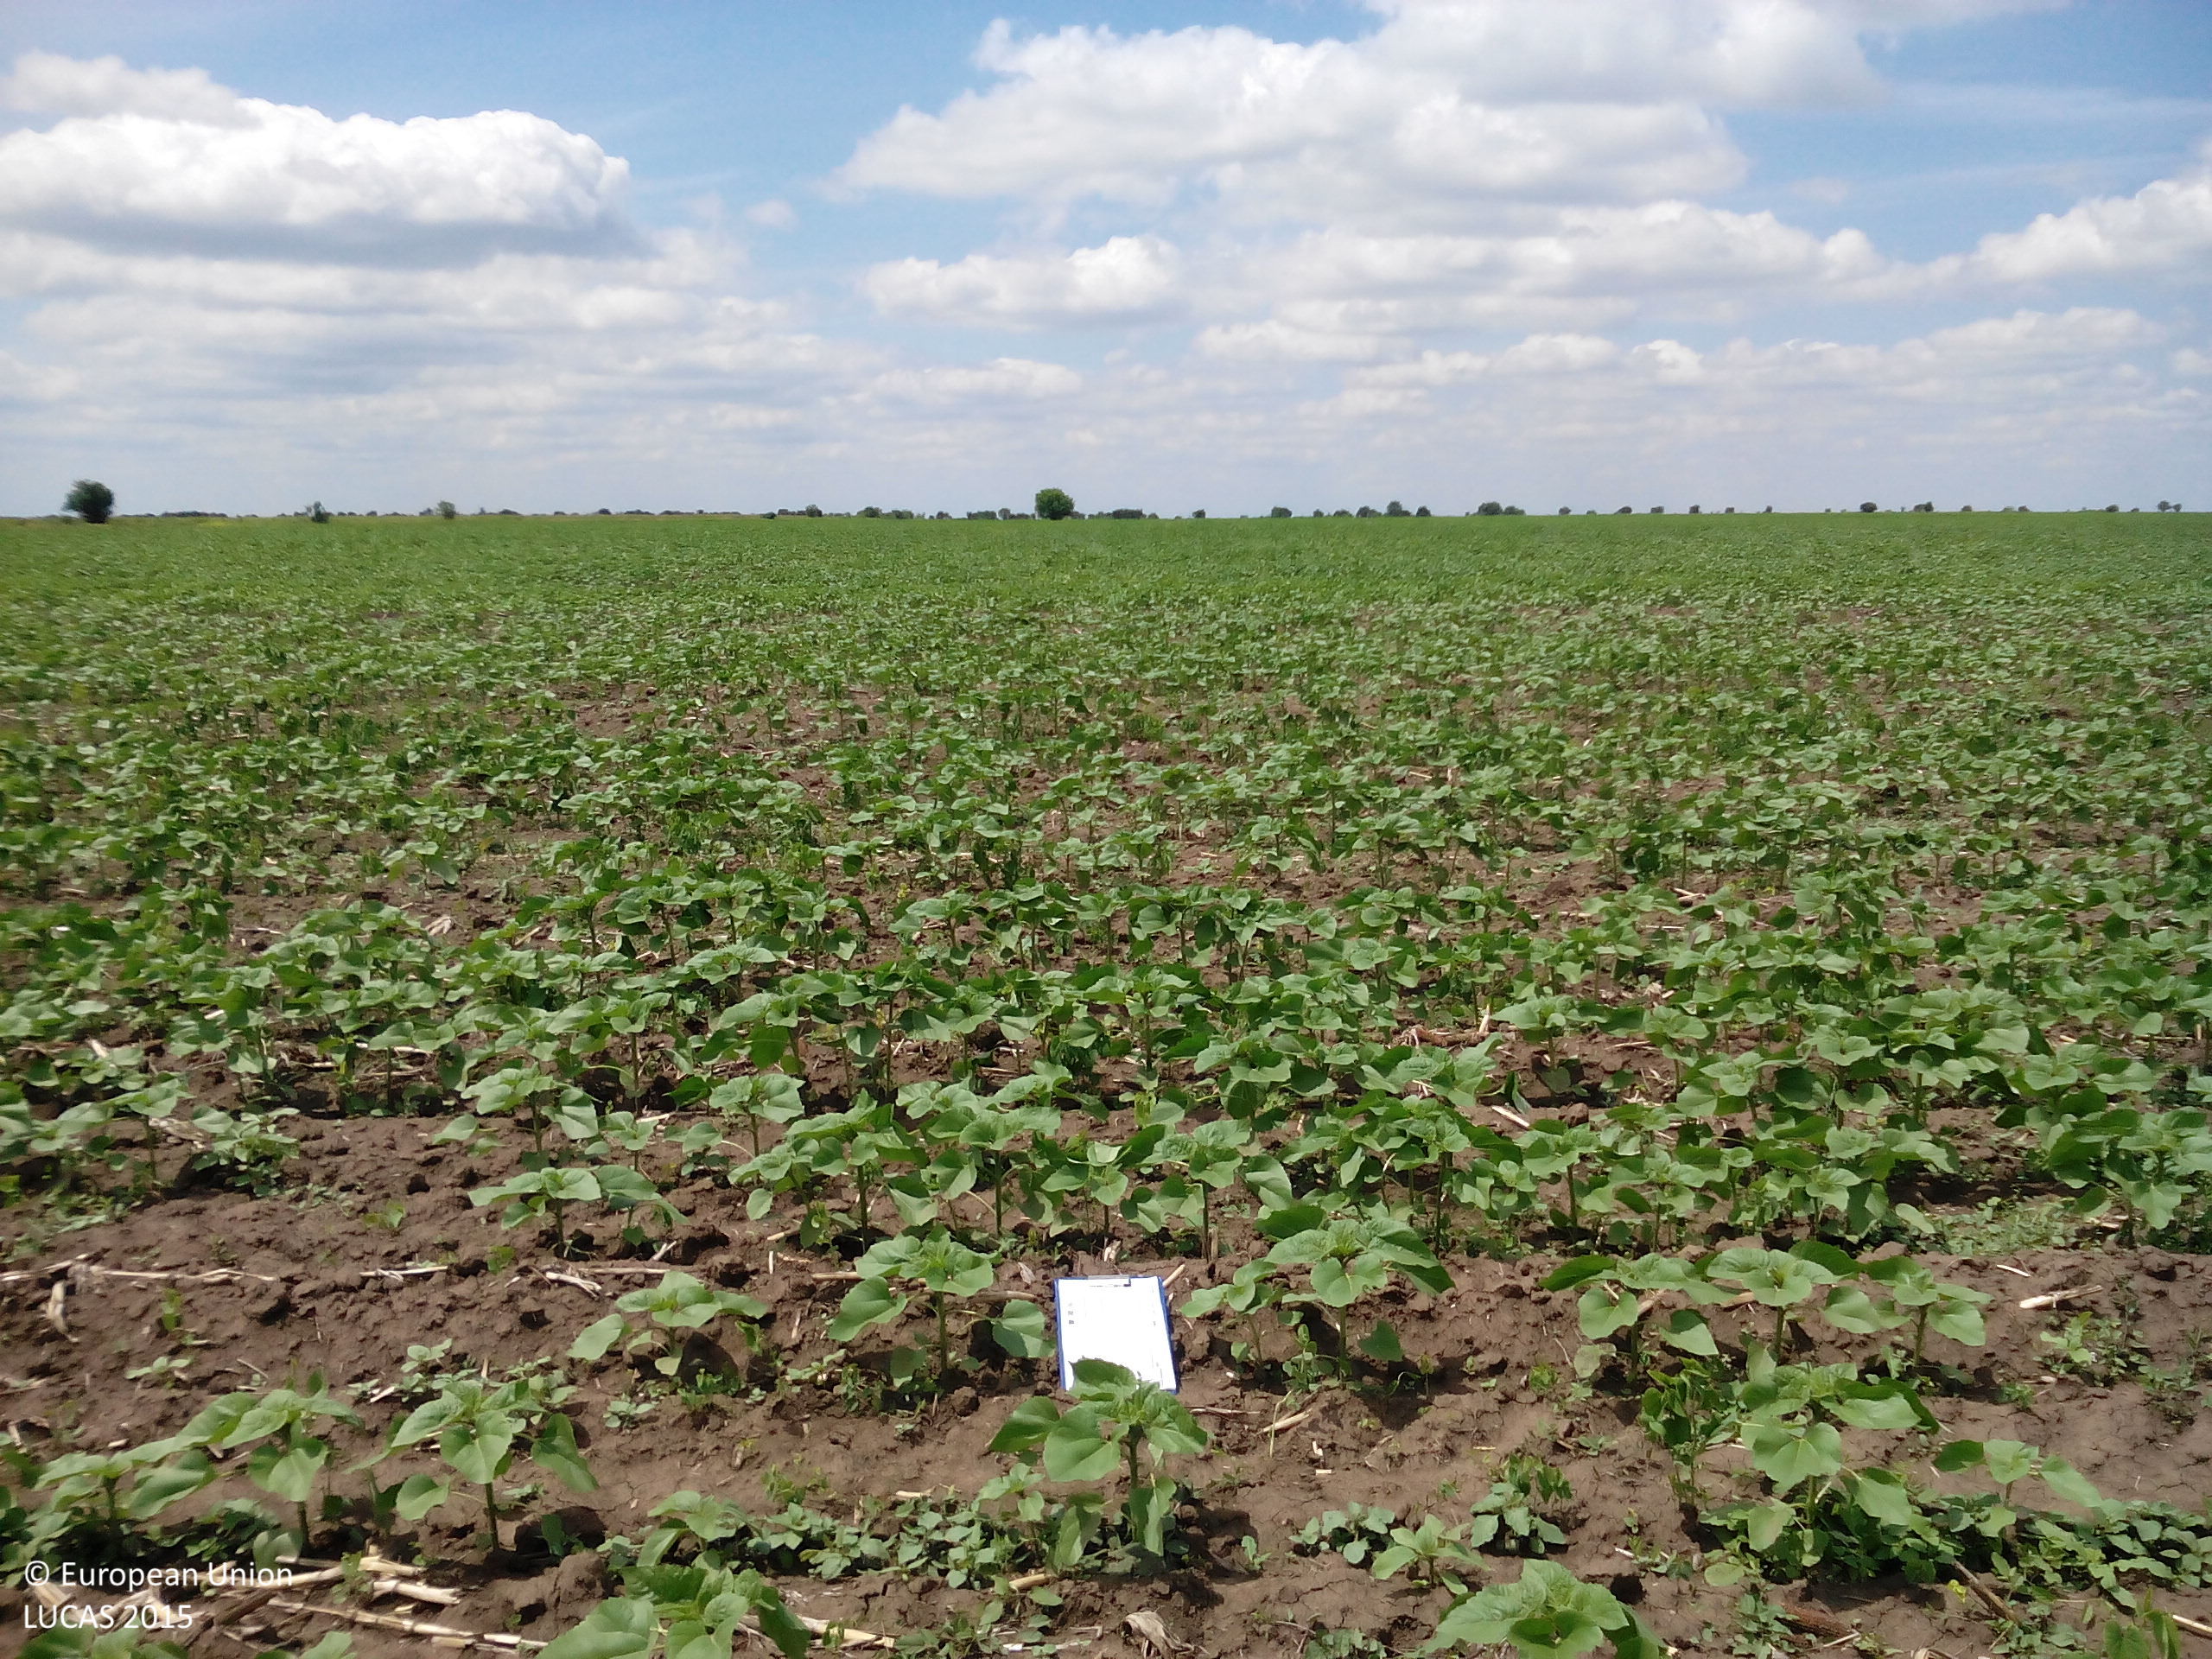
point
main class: Cropland
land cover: Sunflower
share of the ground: 50 - 75 %
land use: Agriculture (excluding fallow land and kitchen gardens)
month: May
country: BG
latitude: 43.5043
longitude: 24.1428
